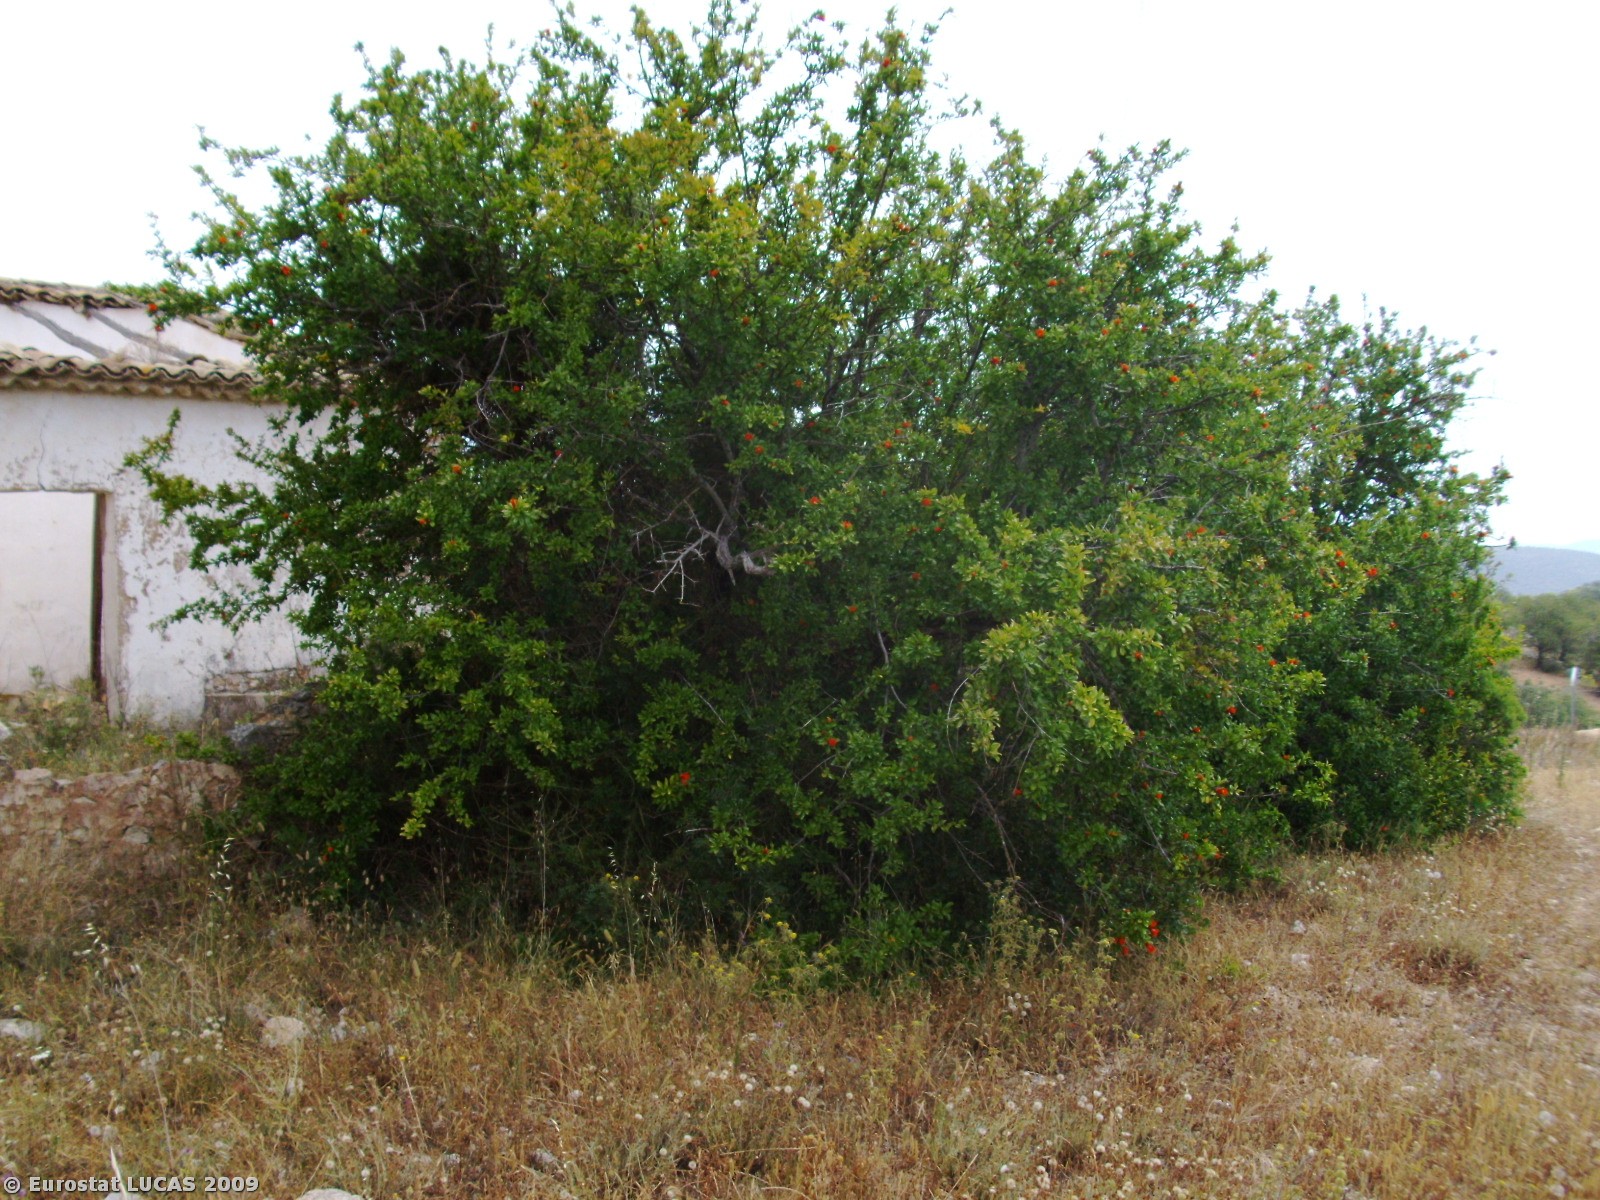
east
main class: Grassland
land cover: Spontaneously vegetated surfaces
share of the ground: 25 - 50 %
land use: Unused
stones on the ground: 25 - 50 %
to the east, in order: Spontaneously vegetated surfaces; Single bushes/trees; Artificial constructions in urban areas; Spontaneously vegetated surfaces; Single bushes/trees; Spontaneously vegetated surfaces; Paved roads, cycling and walking lanes; Nuts trees; Electric lines; Olive groves; Dry stone walls; Tracks; Dry stone walls; Permanent industrial crops; Dry stone walls; Bare land; Dry stone walls
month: May
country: PT
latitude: 37.1510
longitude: -8.1553
